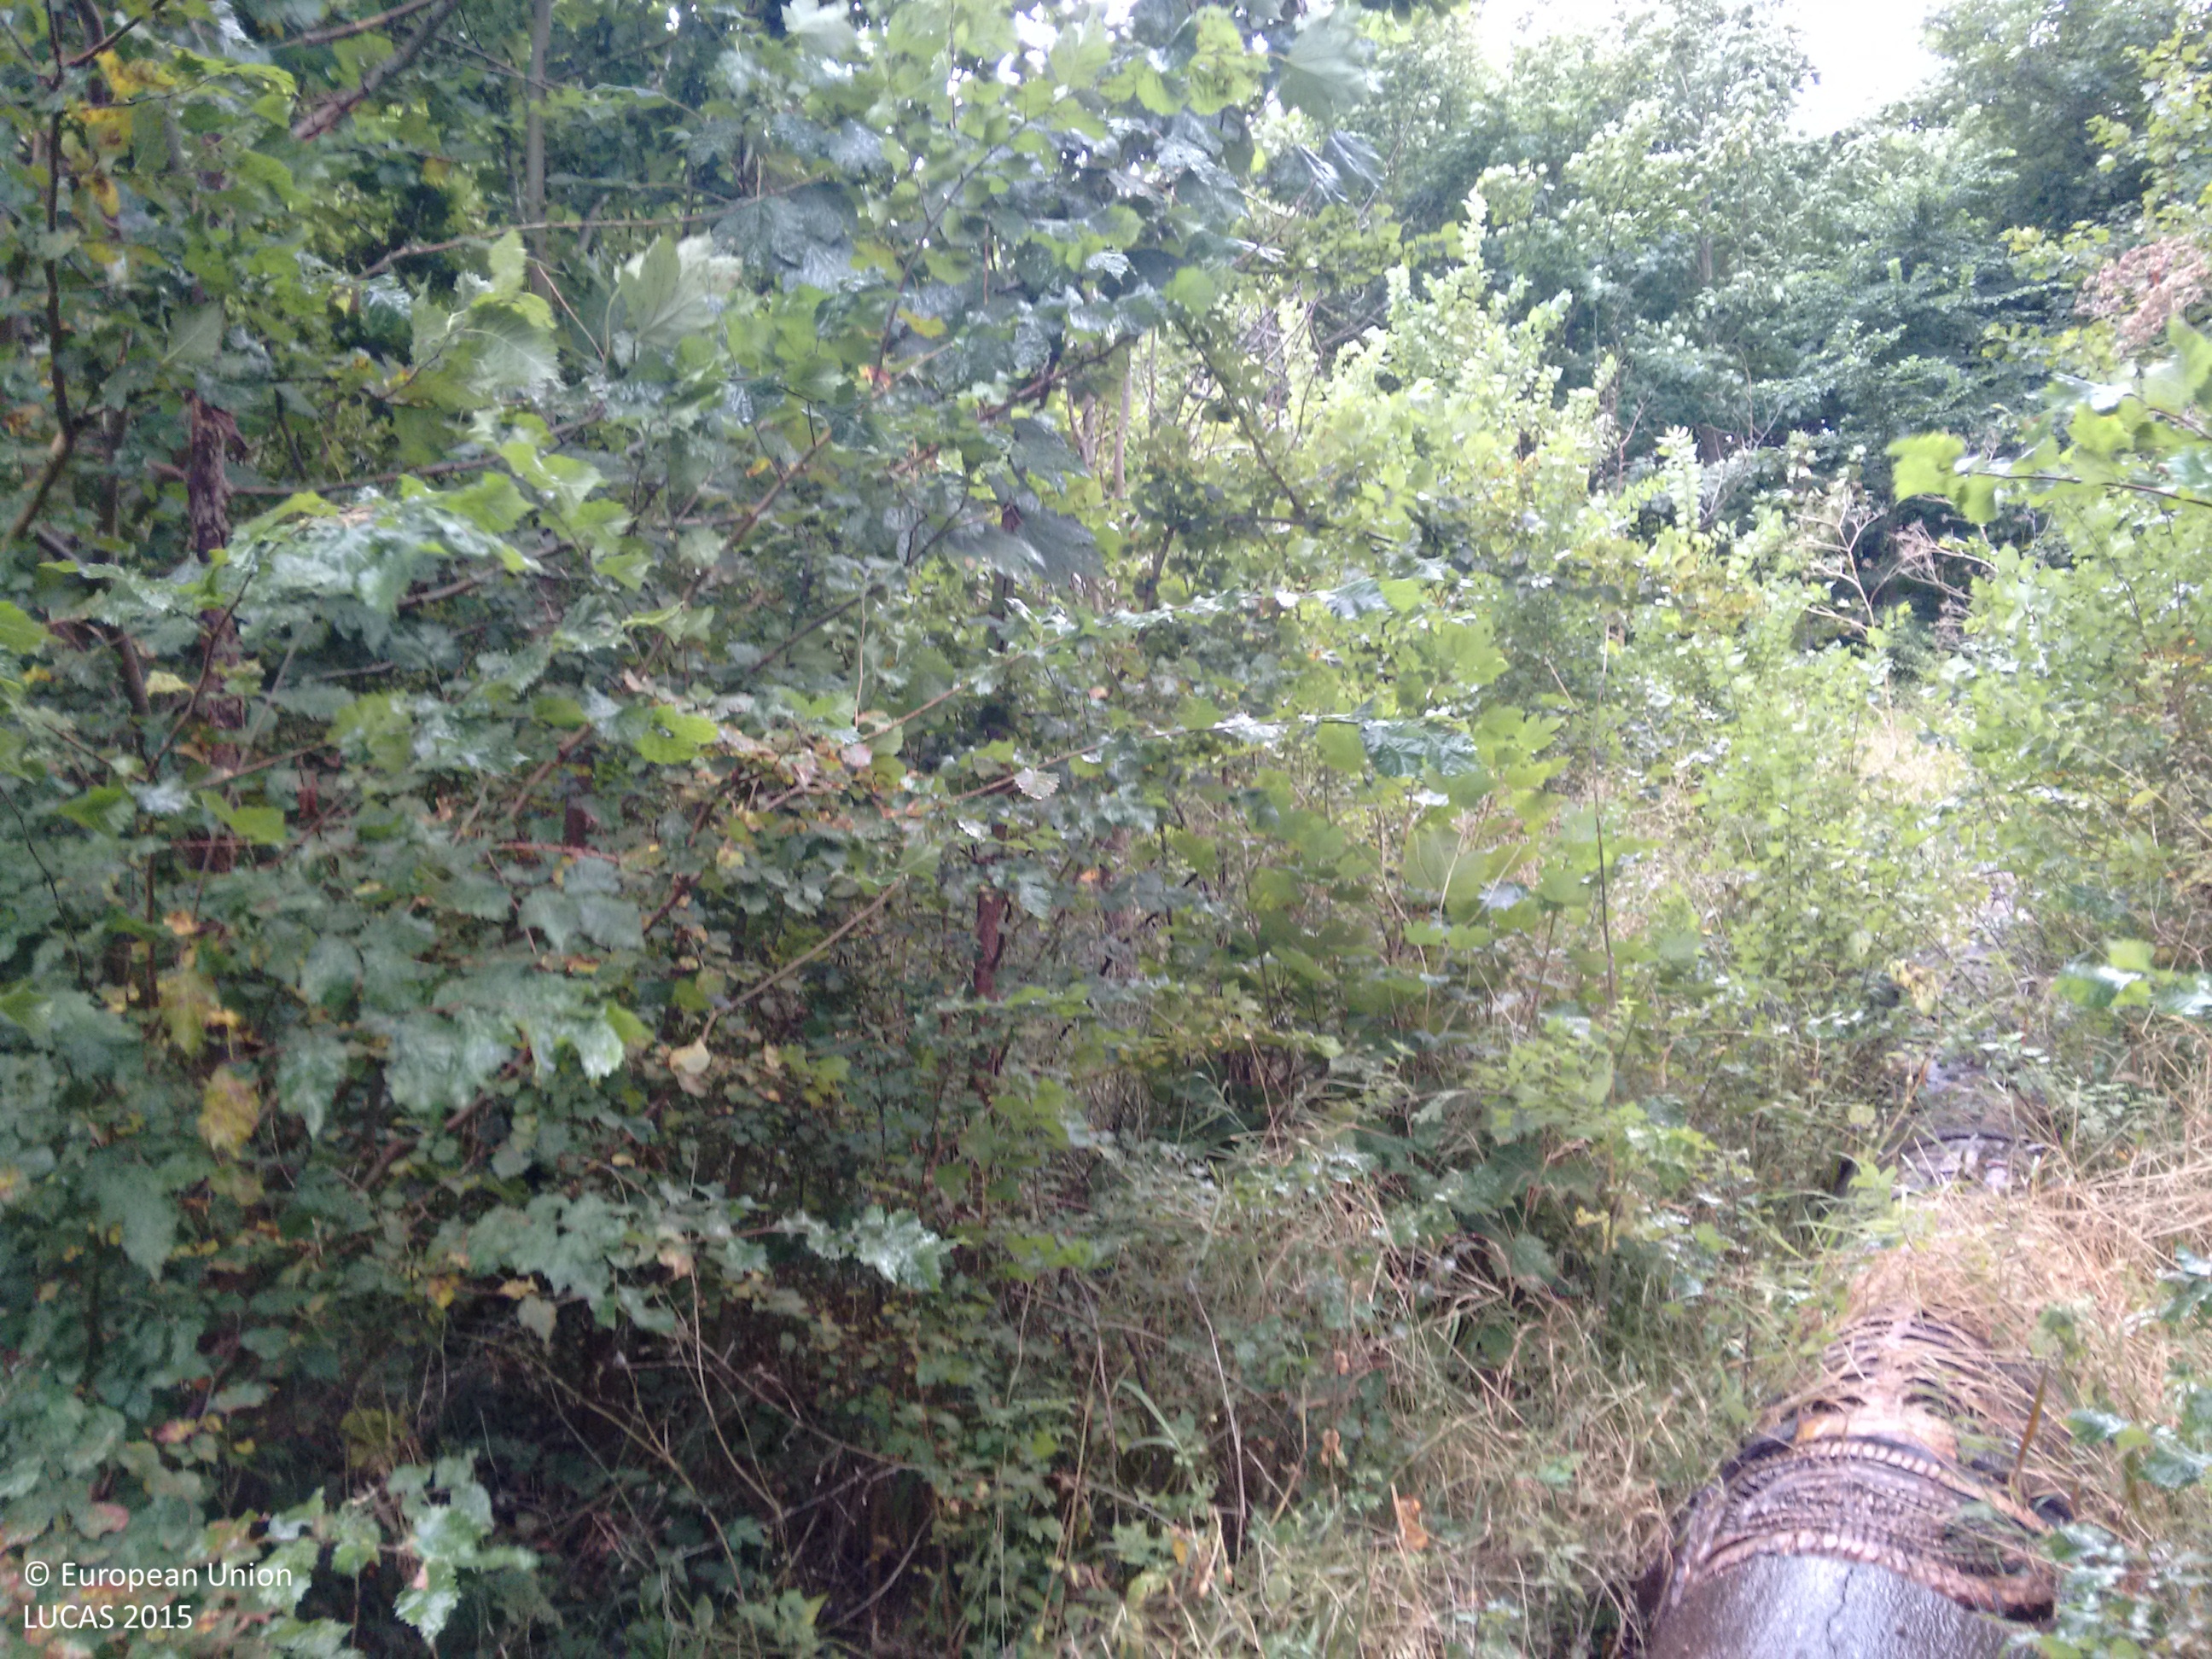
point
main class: Woodland
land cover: Broadleaved woodland
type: mesophytic deciduous forest
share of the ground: > 75 %
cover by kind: broadleaved forest trees 100 %
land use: Amenities, museums, leisure
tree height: > 5 m
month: September
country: GB
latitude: 52.6210
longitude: 1.3385
